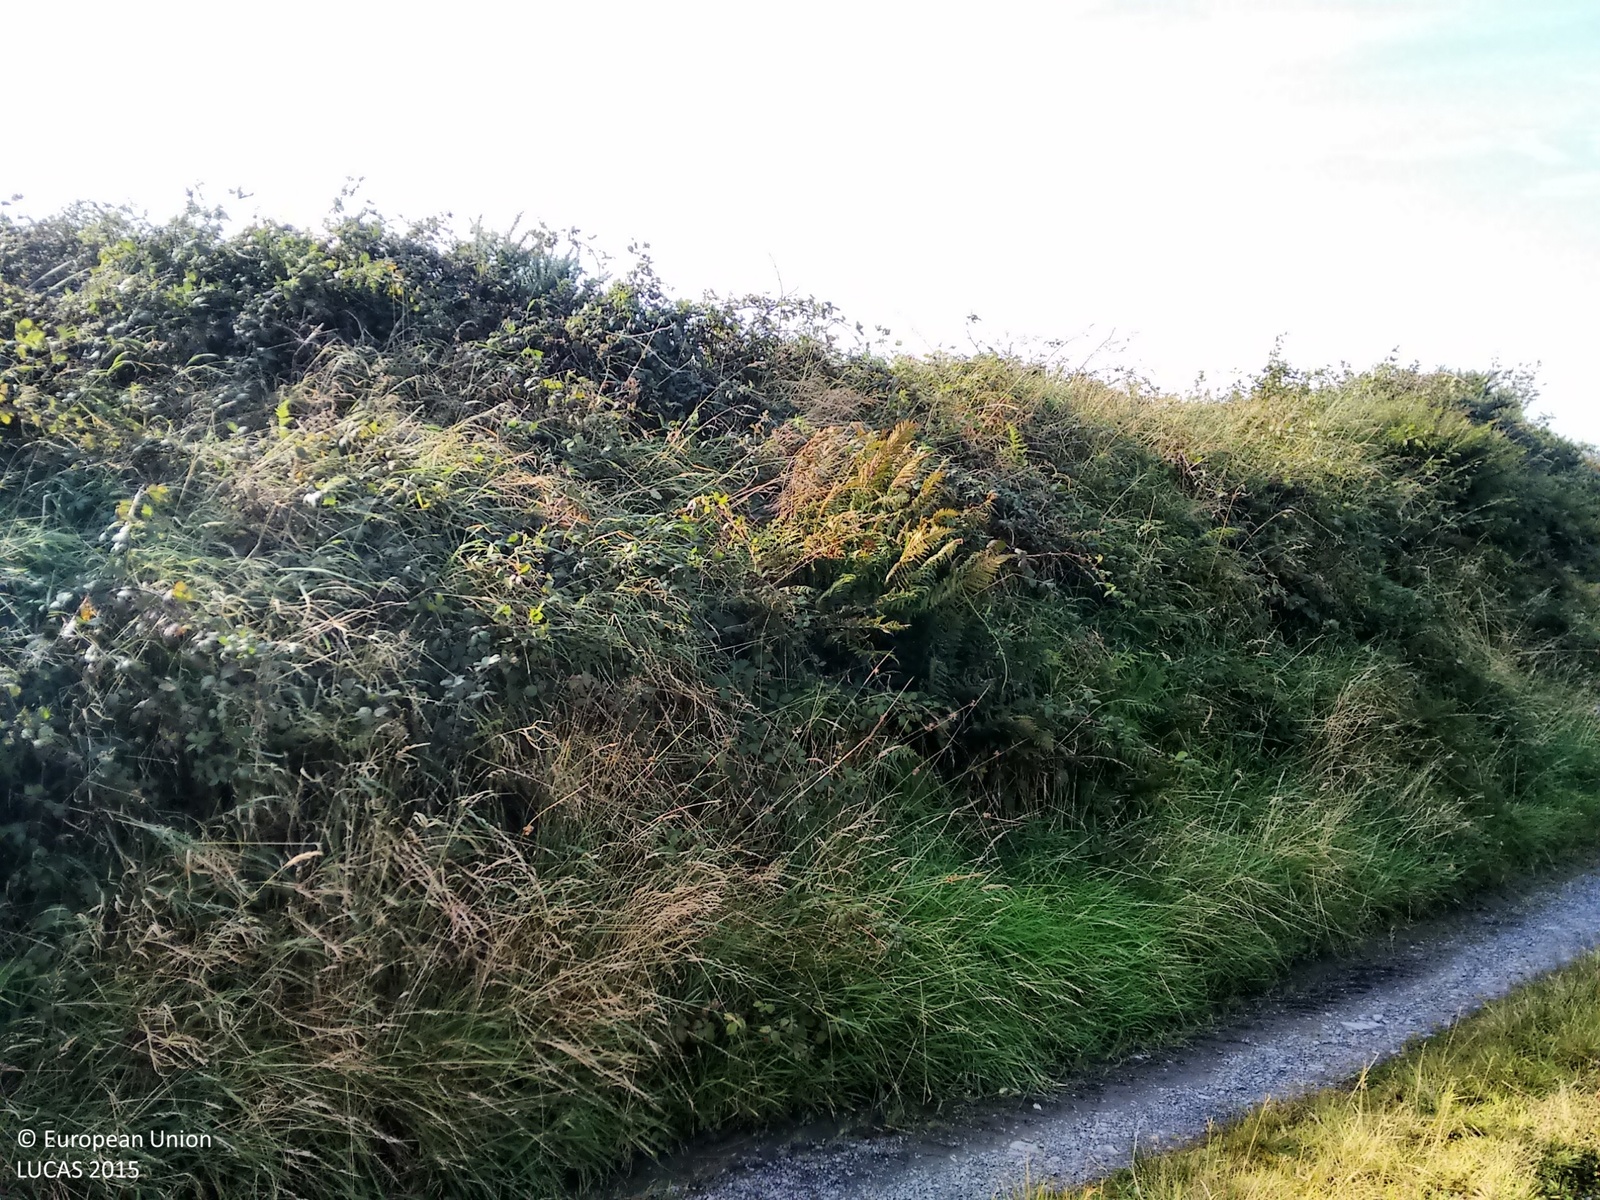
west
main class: Grassland
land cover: Grassland without tree/shrub cover
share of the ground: > 75 %
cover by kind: herbaceous plants 100 %
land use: Agriculture (excluding fallow land and kitchen gardens)
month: September
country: IE
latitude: 52.8714
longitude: -9.2541
